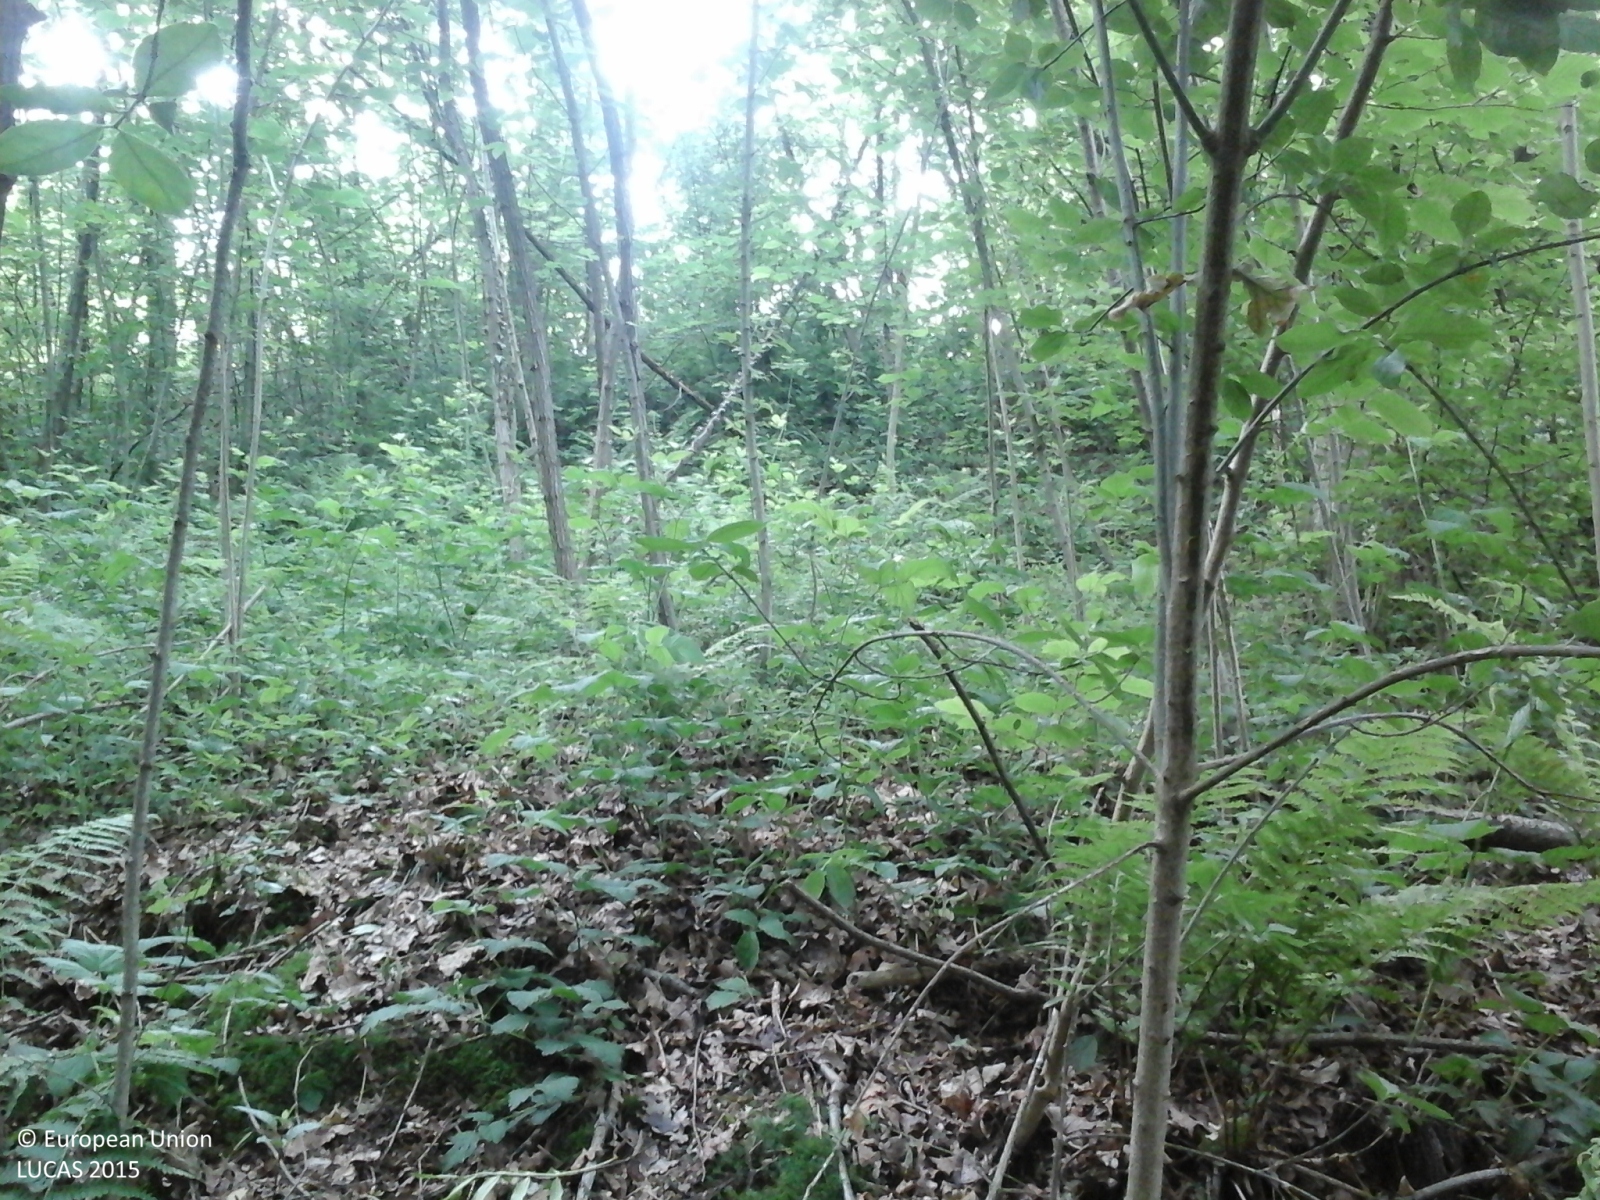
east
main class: Woodland
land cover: Broadleaved woodland
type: mesophytic deciduous forest
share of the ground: > 75 %
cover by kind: broadleaved forest trees 100 %
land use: Forestry
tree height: > 5 m
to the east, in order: Broadleaved woodland; Grassland without tree/shrub cover; Vineyards; Spontaneously vegetated surfaces; Broadleaved woodland; Ditches and canals; Dry stone walls; Broadleaved woodland; Vineyards; Grassland with sparse tree/shrub cover; Single bushes/trees; Electric lines; Fences; Other fresh vegetables
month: May
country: IT
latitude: 45.5791
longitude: 8.1958
